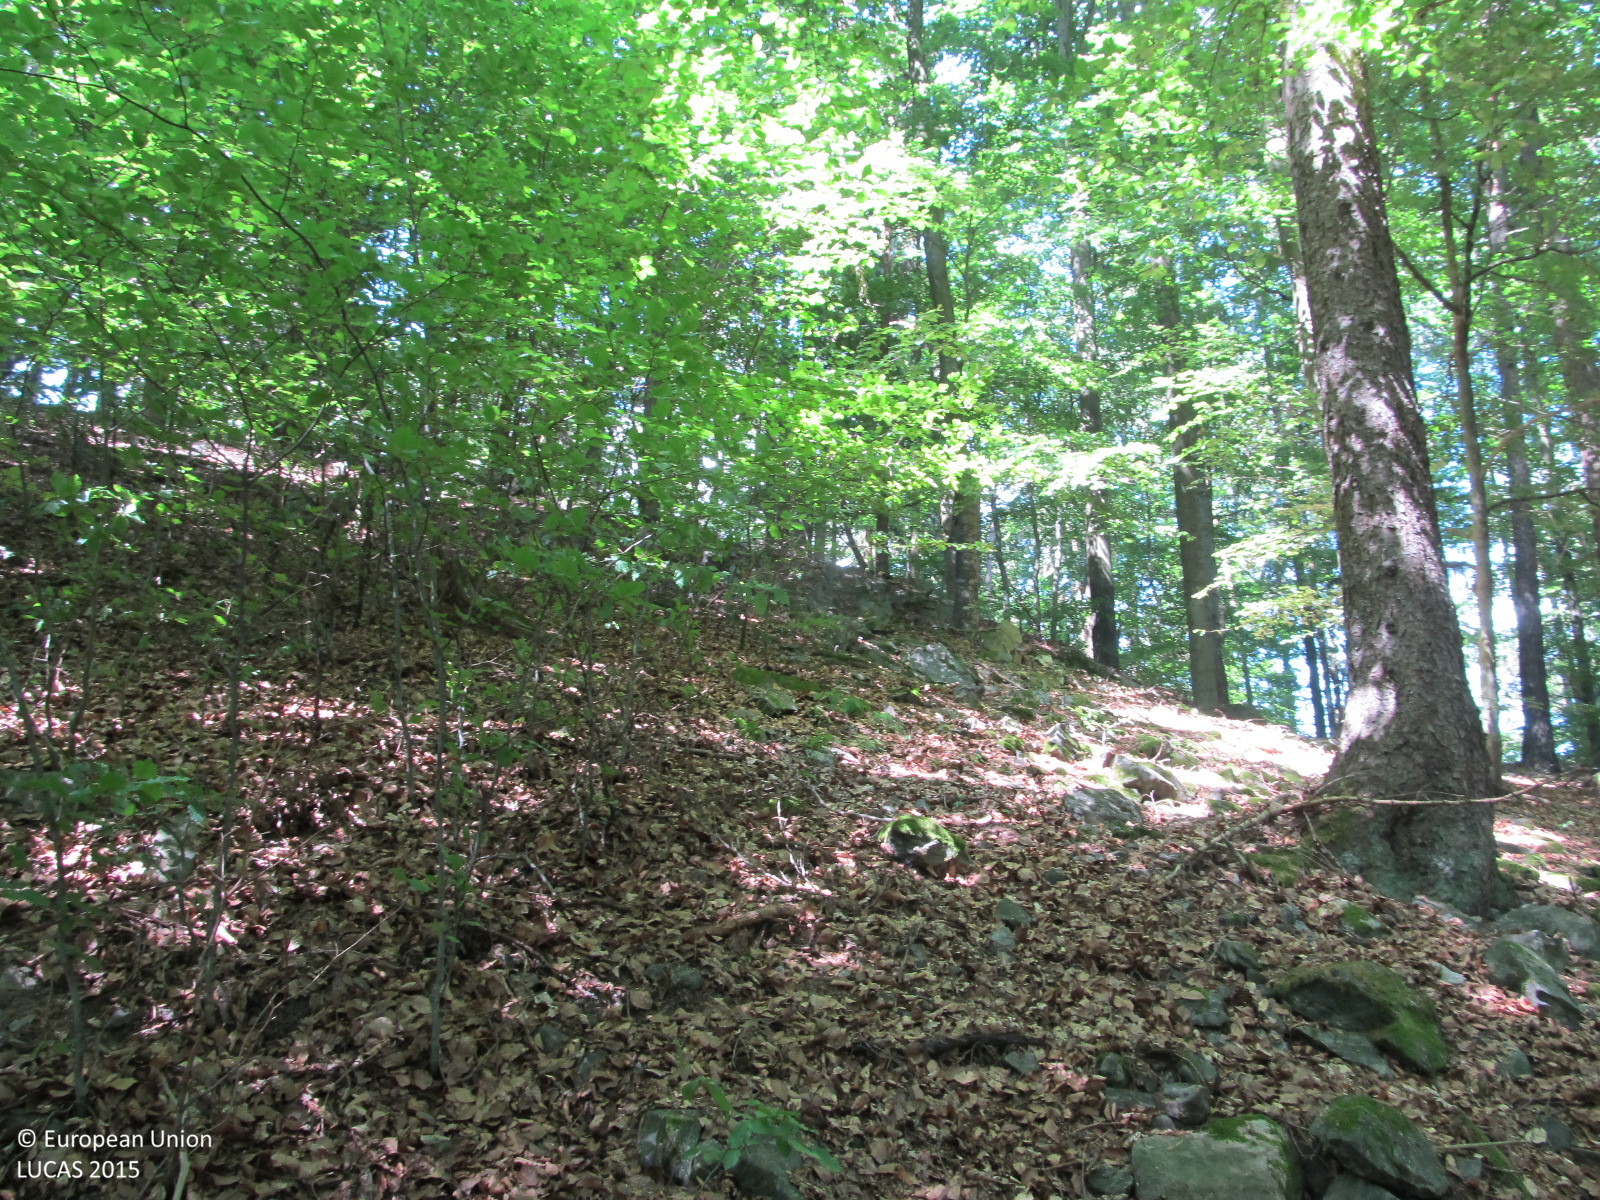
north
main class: Woodland
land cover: Other mixed woodland
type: beech forest
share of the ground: > 75 %
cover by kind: broadleaved forest trees 60 %, coniferous forest trees 25 %, unconsolidated bare surface 10 %, shrubs 5 %
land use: Forestry
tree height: > 5 m
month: July
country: AT
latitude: 48.2906
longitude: 15.3800
